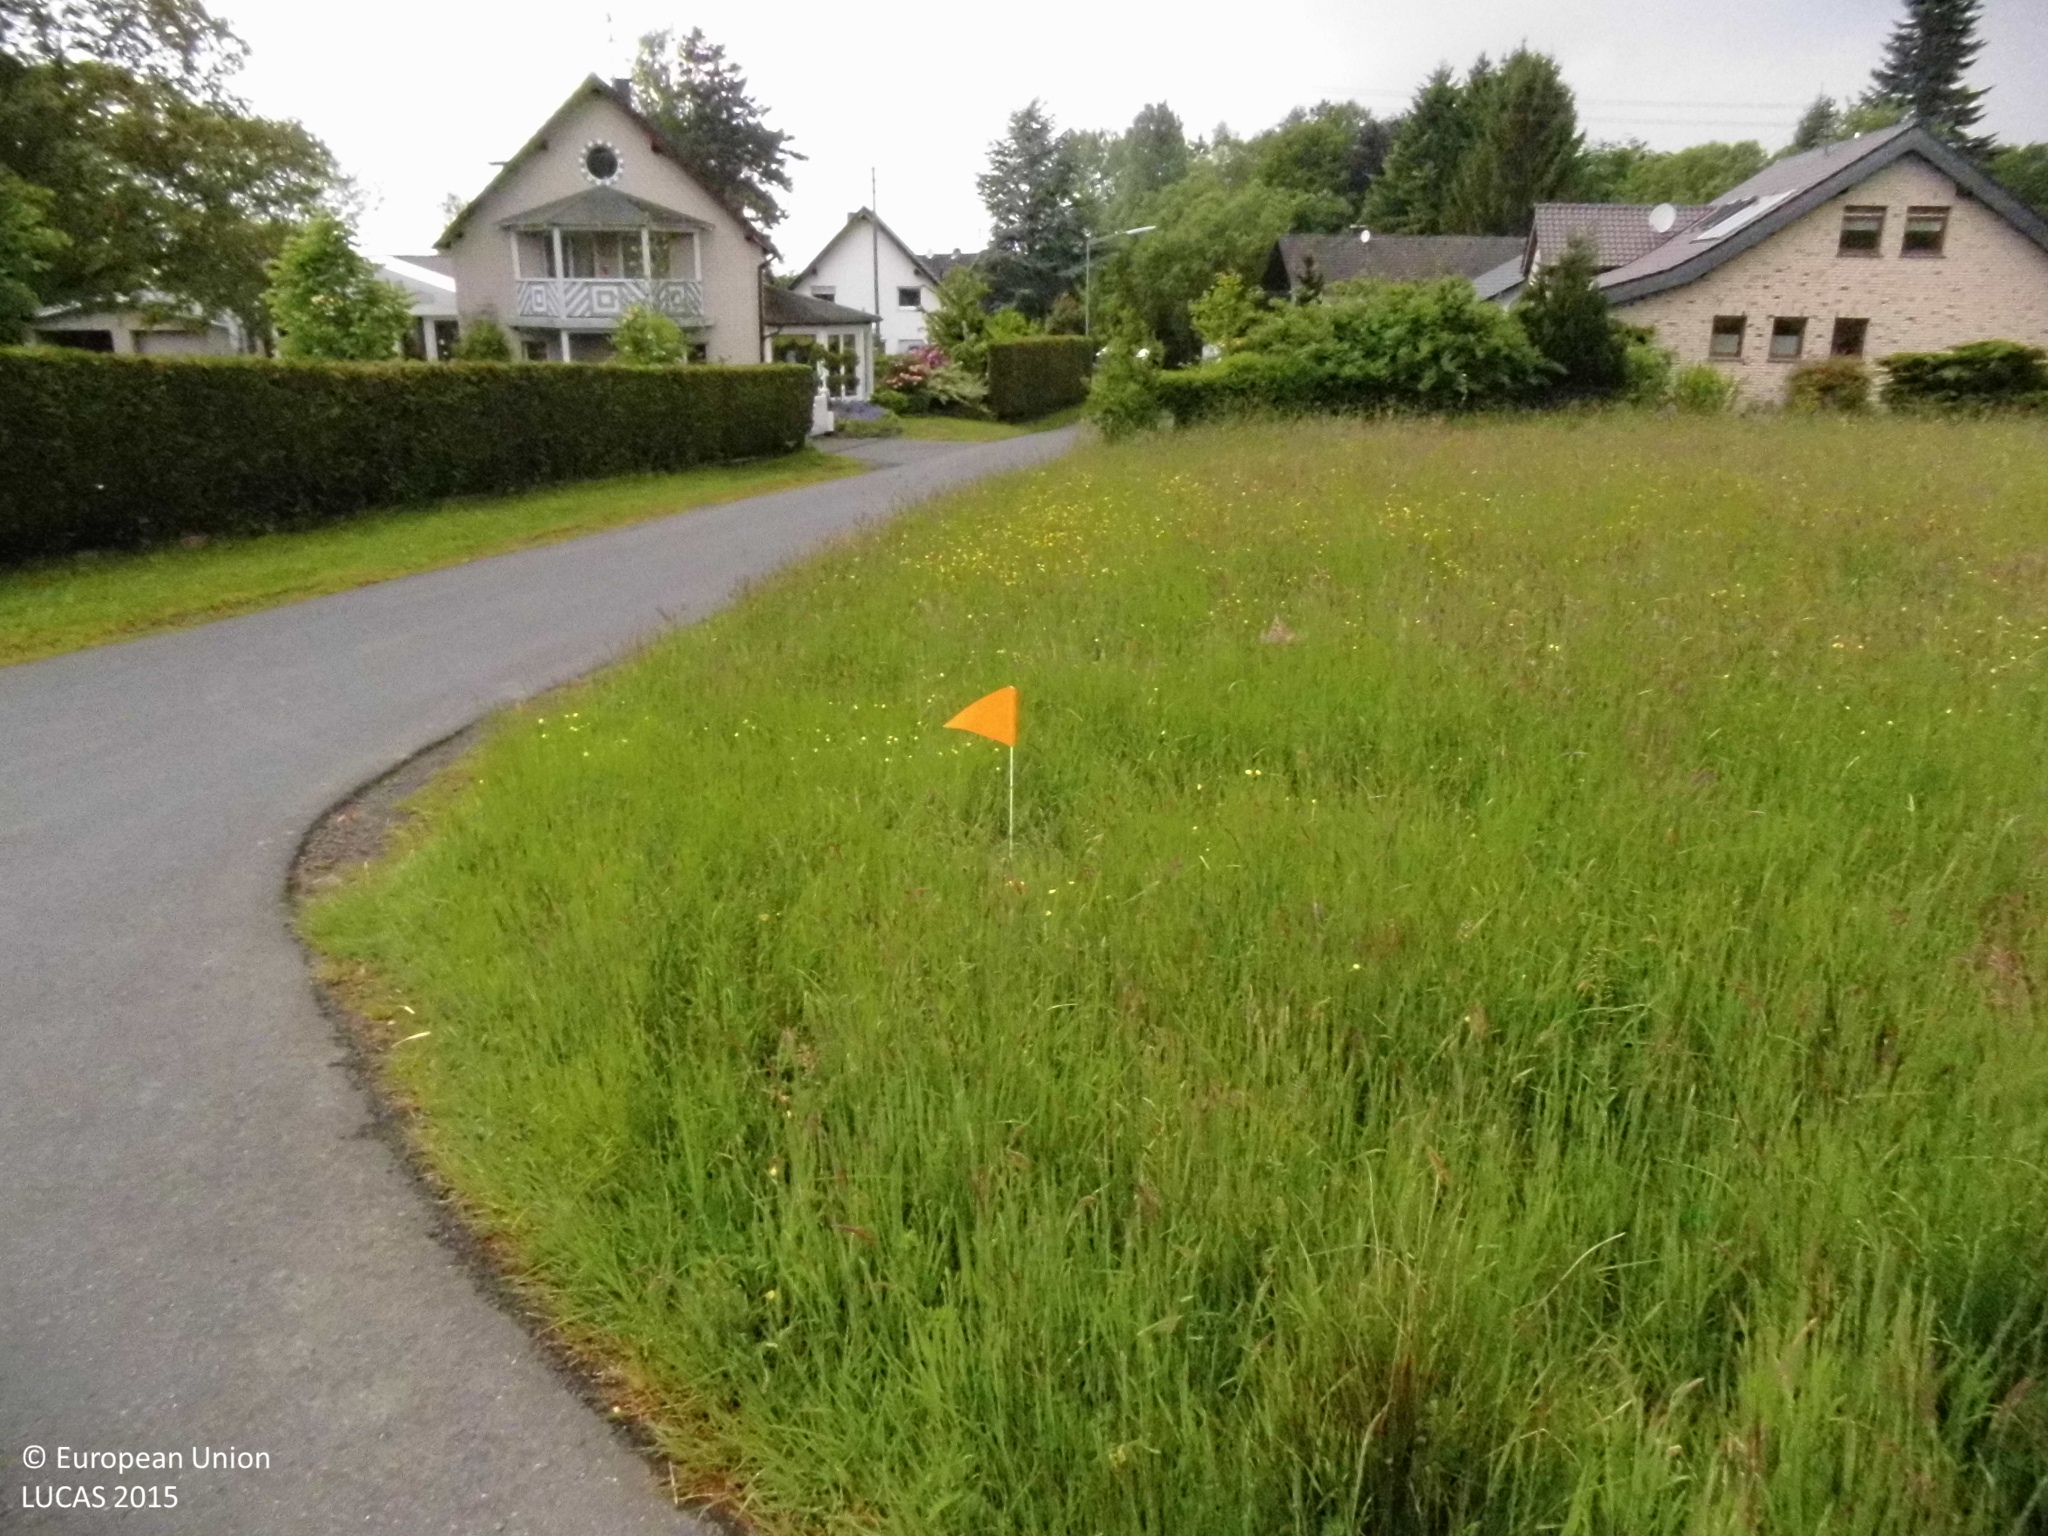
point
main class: Grassland
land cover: Grassland without tree/shrub cover
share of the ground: > 75 %
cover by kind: herbaceous plants 100 %
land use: Agriculture (excluding fallow land and kitchen gardens)
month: May
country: DE
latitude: 50.6958
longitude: 7.4661
